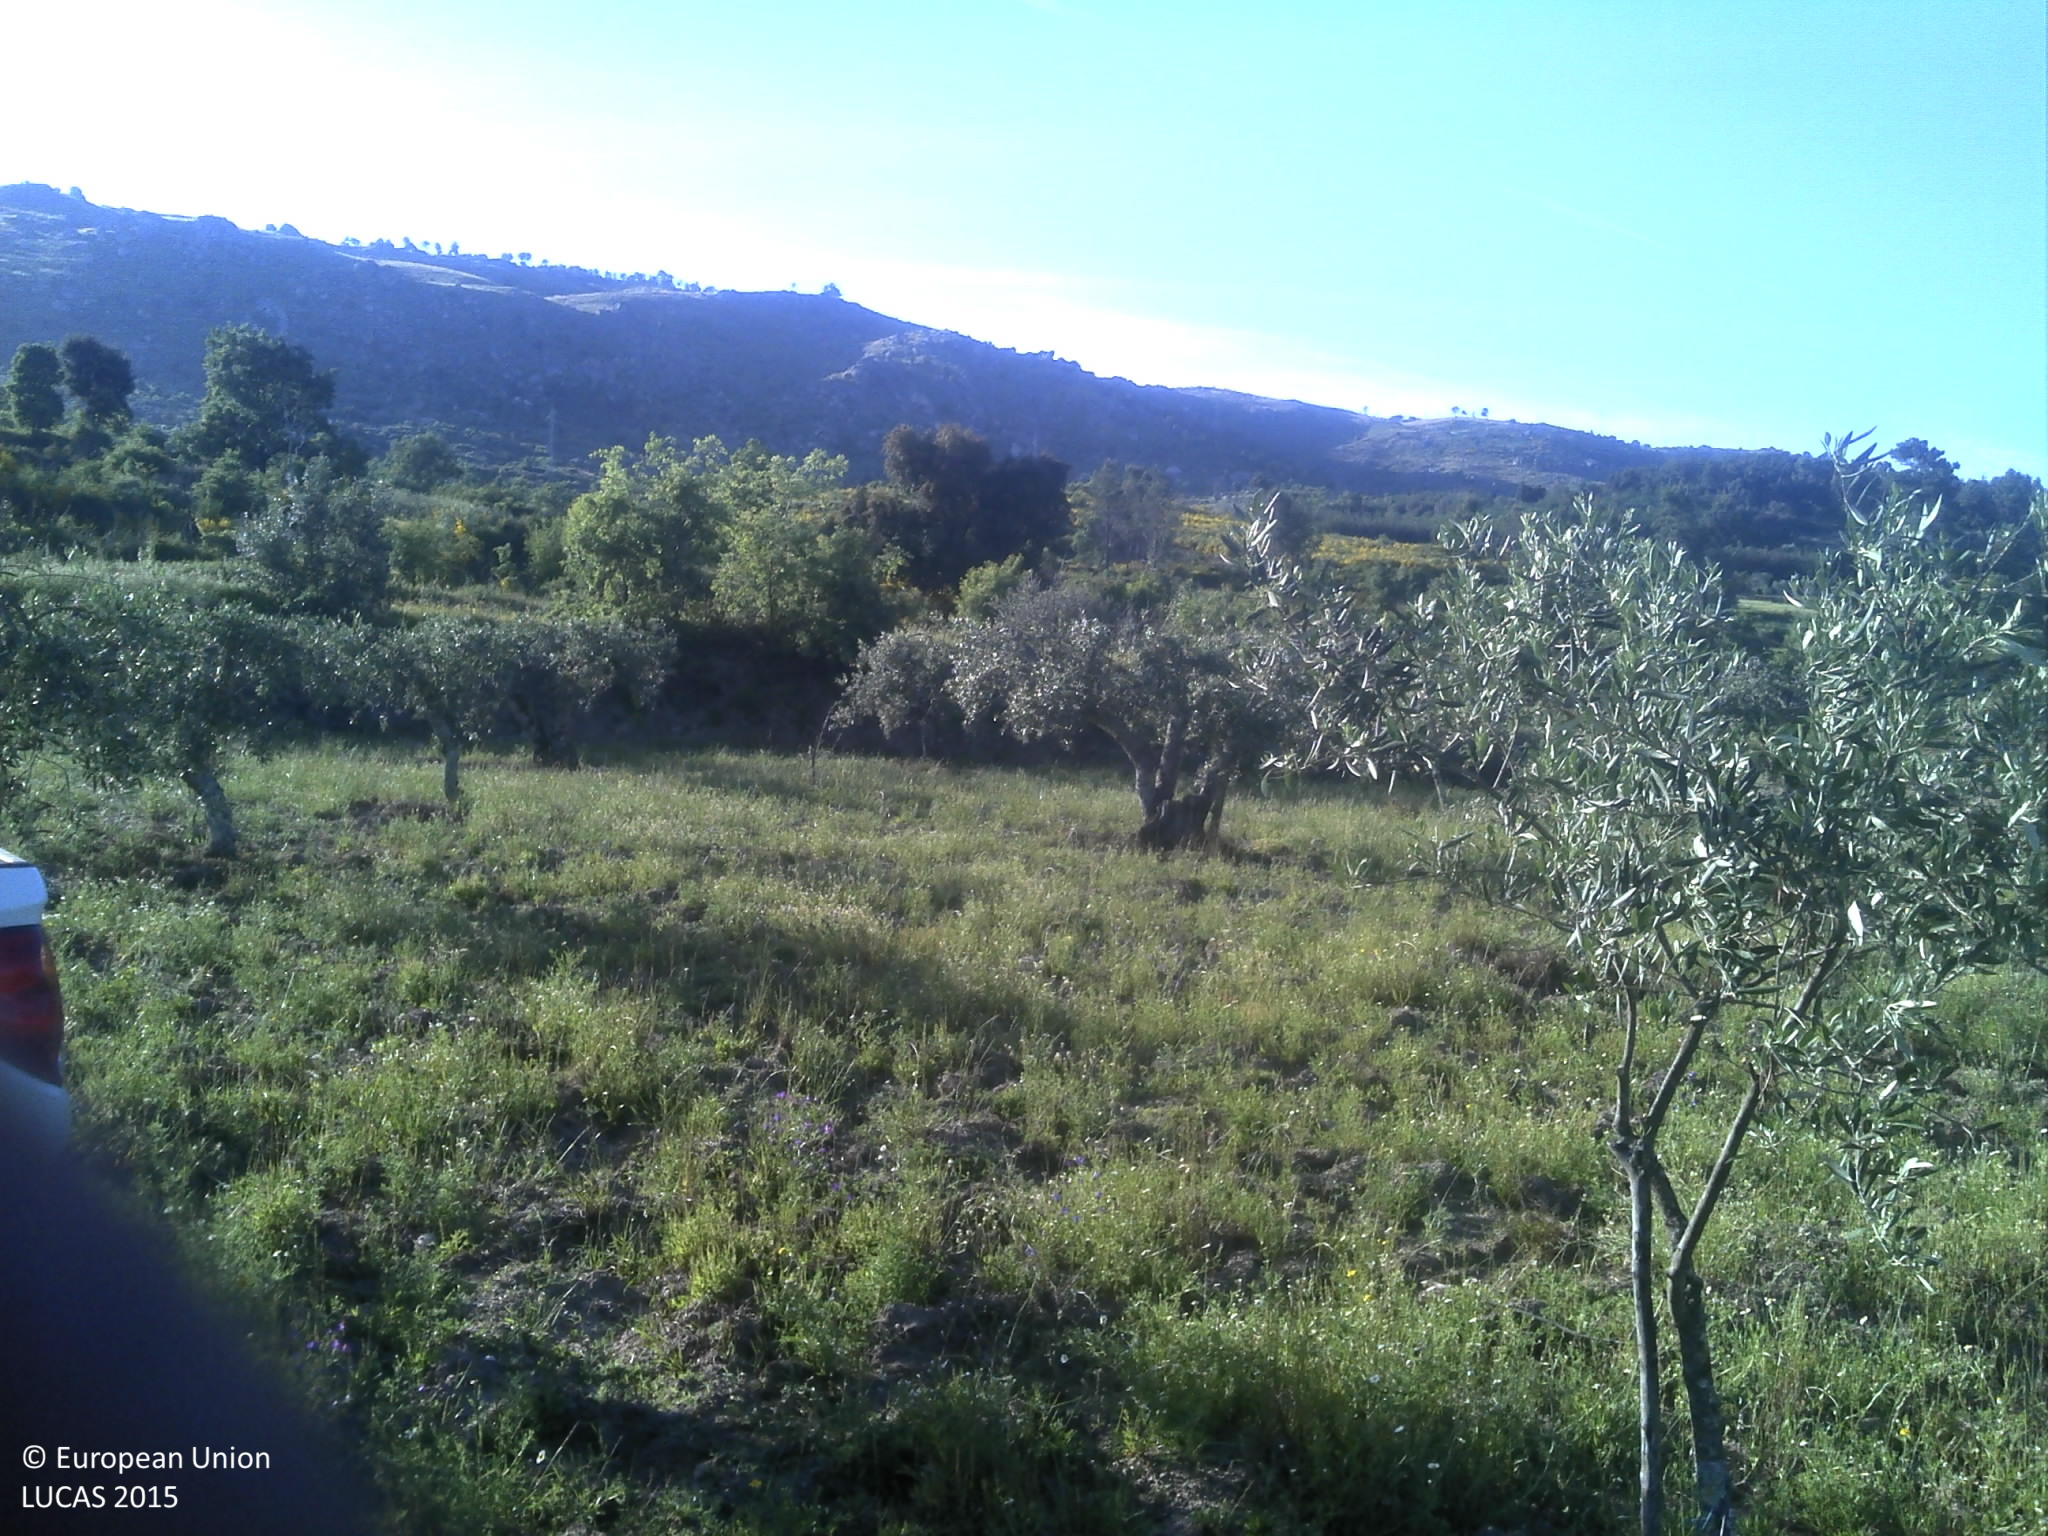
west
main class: Cropland
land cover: Olive groves
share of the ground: 25 - 50 %
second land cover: Grassland without tree/shrub cover
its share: 25 - 50 %
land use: Agriculture (excluding fallow land and kitchen gardens)
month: May
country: PT
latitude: 40.7174
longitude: -7.3592
